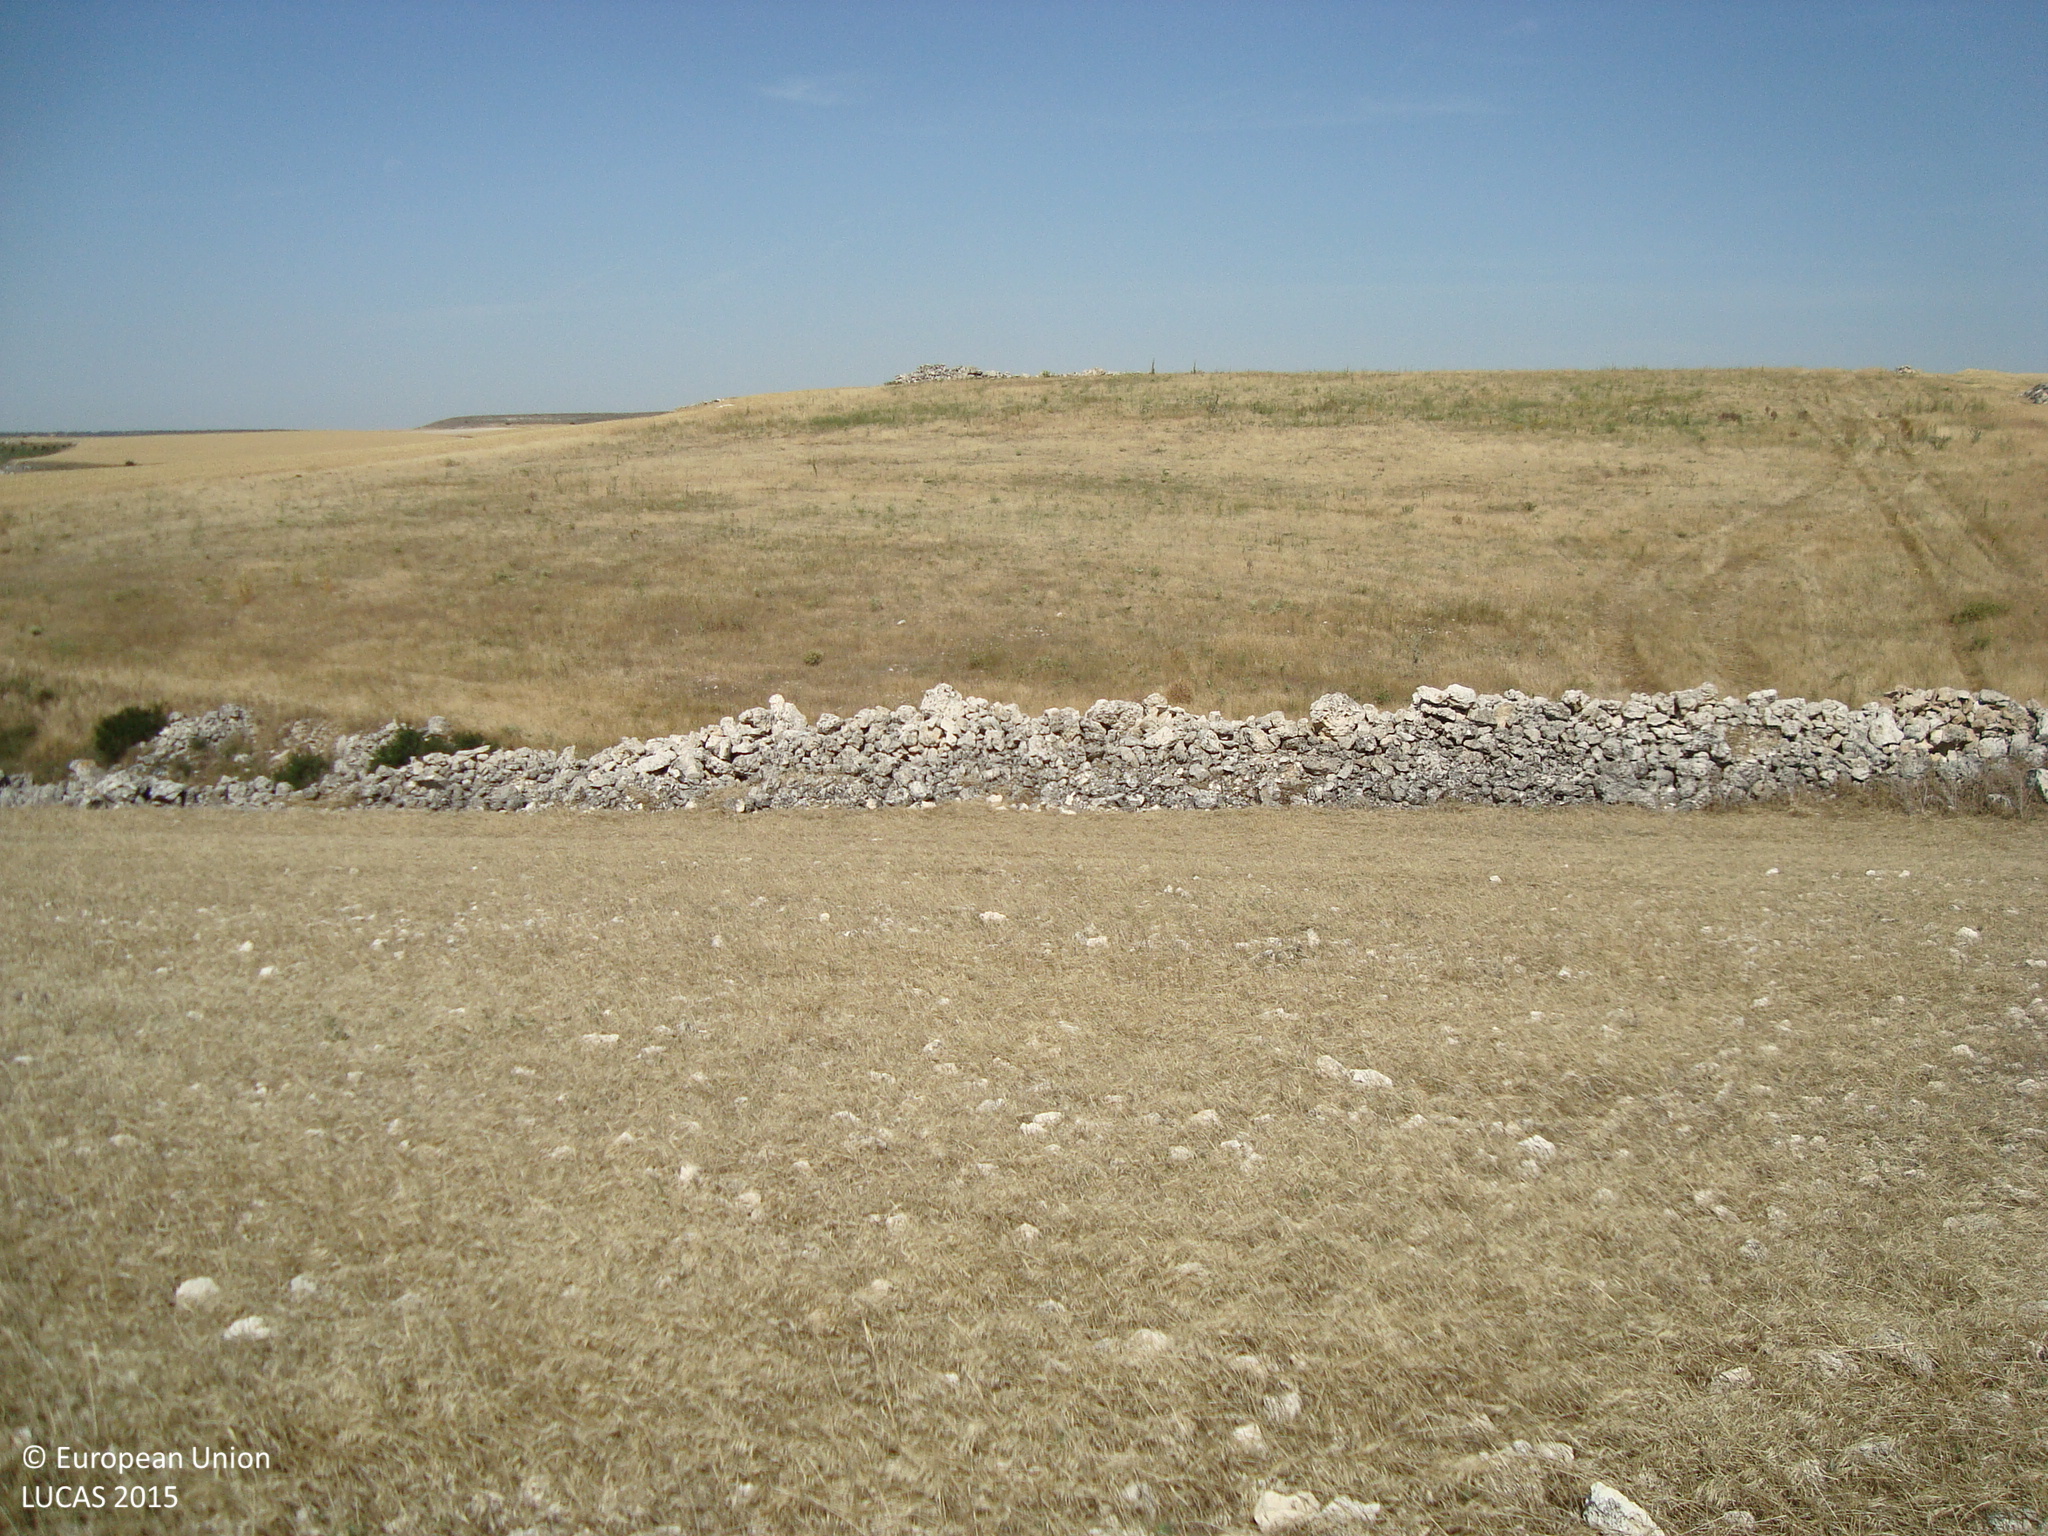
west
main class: Grassland
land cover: Grassland without tree/shrub cover
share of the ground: > 75 %
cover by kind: herbaceous plants 90 %, unconsolidated bare surface 10 %
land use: Abandoned areas
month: July
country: ES
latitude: 41.8409
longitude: -3.8706
